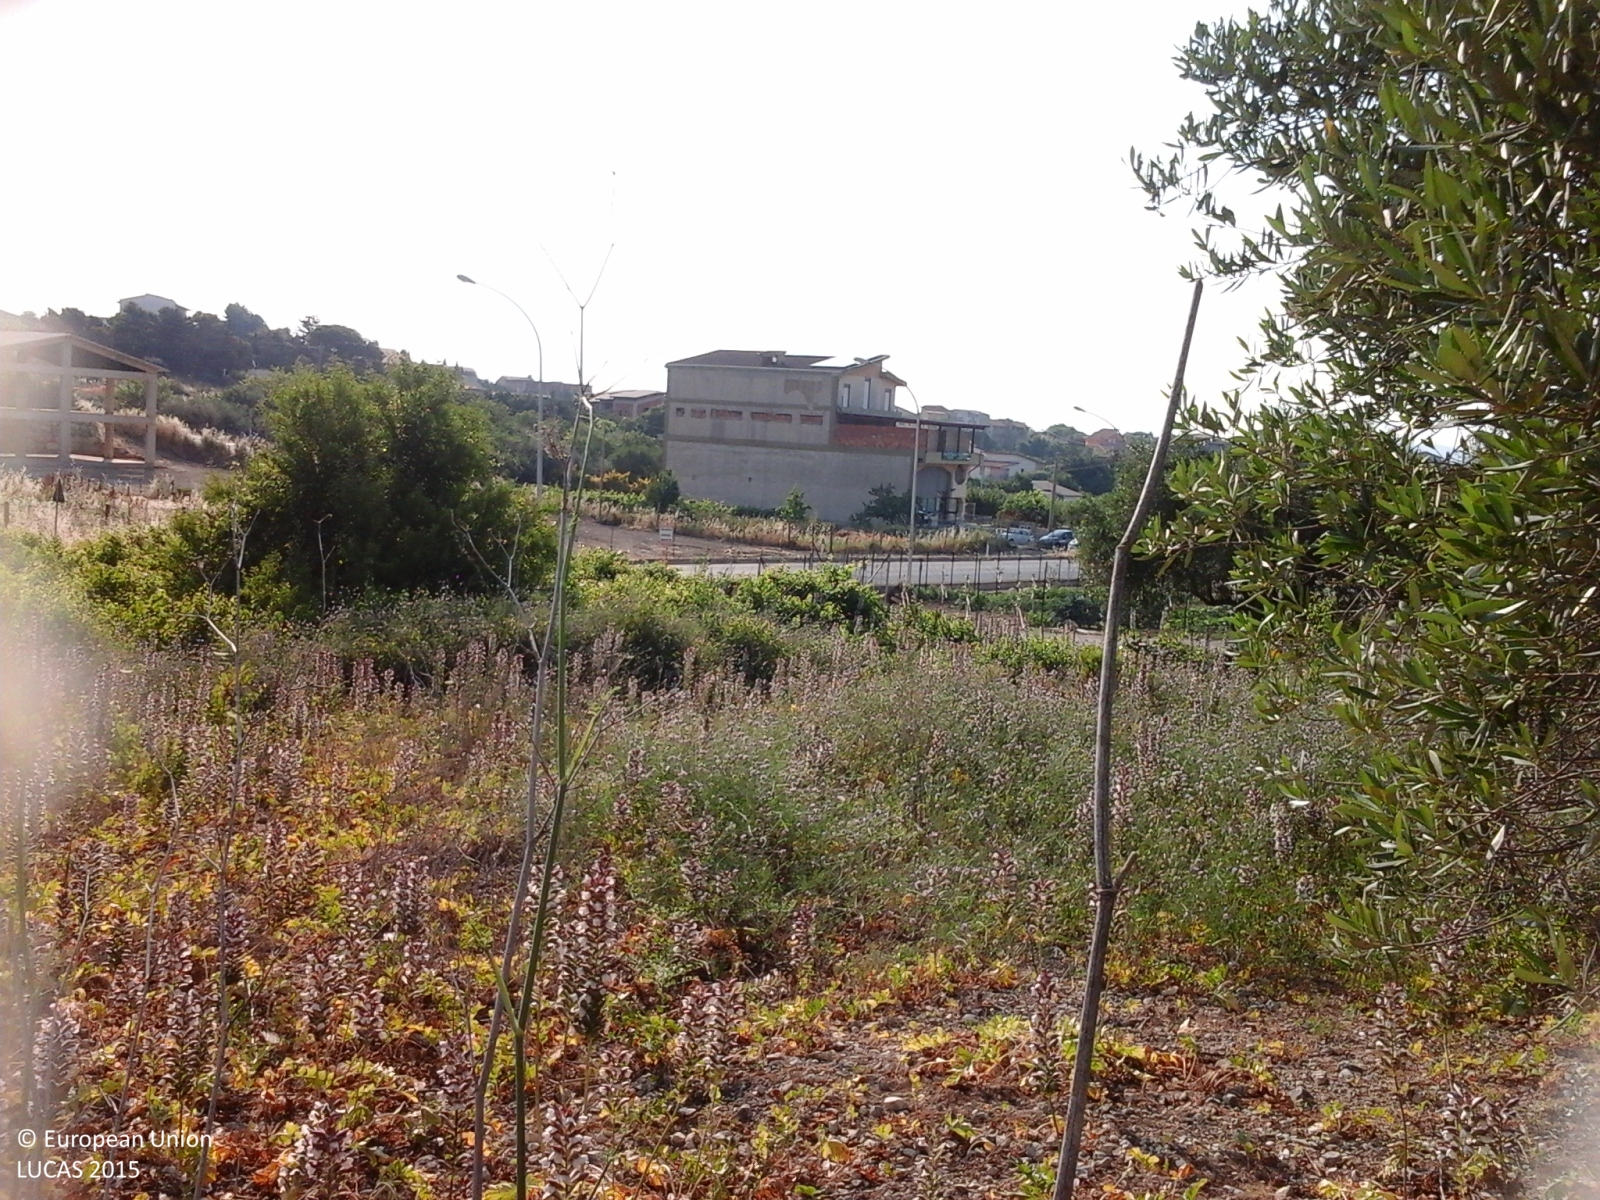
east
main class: Cropland
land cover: Olive groves
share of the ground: 25 - 50 %
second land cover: Spontaneously vegetated surfaces
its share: > 75 %
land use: Agriculture (excluding fallow land and kitchen gardens)
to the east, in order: Olive groves; Spontaneously vegetated surfaces; Grassland without tree/shrub cover; Paved roads, cycling and walking lanes; Fences; Other bare soil; Fences; Other fresh vegetables; Vineyards; Other fruit trees and berries; Artificial constructions in urban areas; Nuts trees; Olive groves; Spontaneously vegetated surfaces; Artificial constructions in urban areas
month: June
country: IT
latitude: 37.3912
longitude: 13.5307
